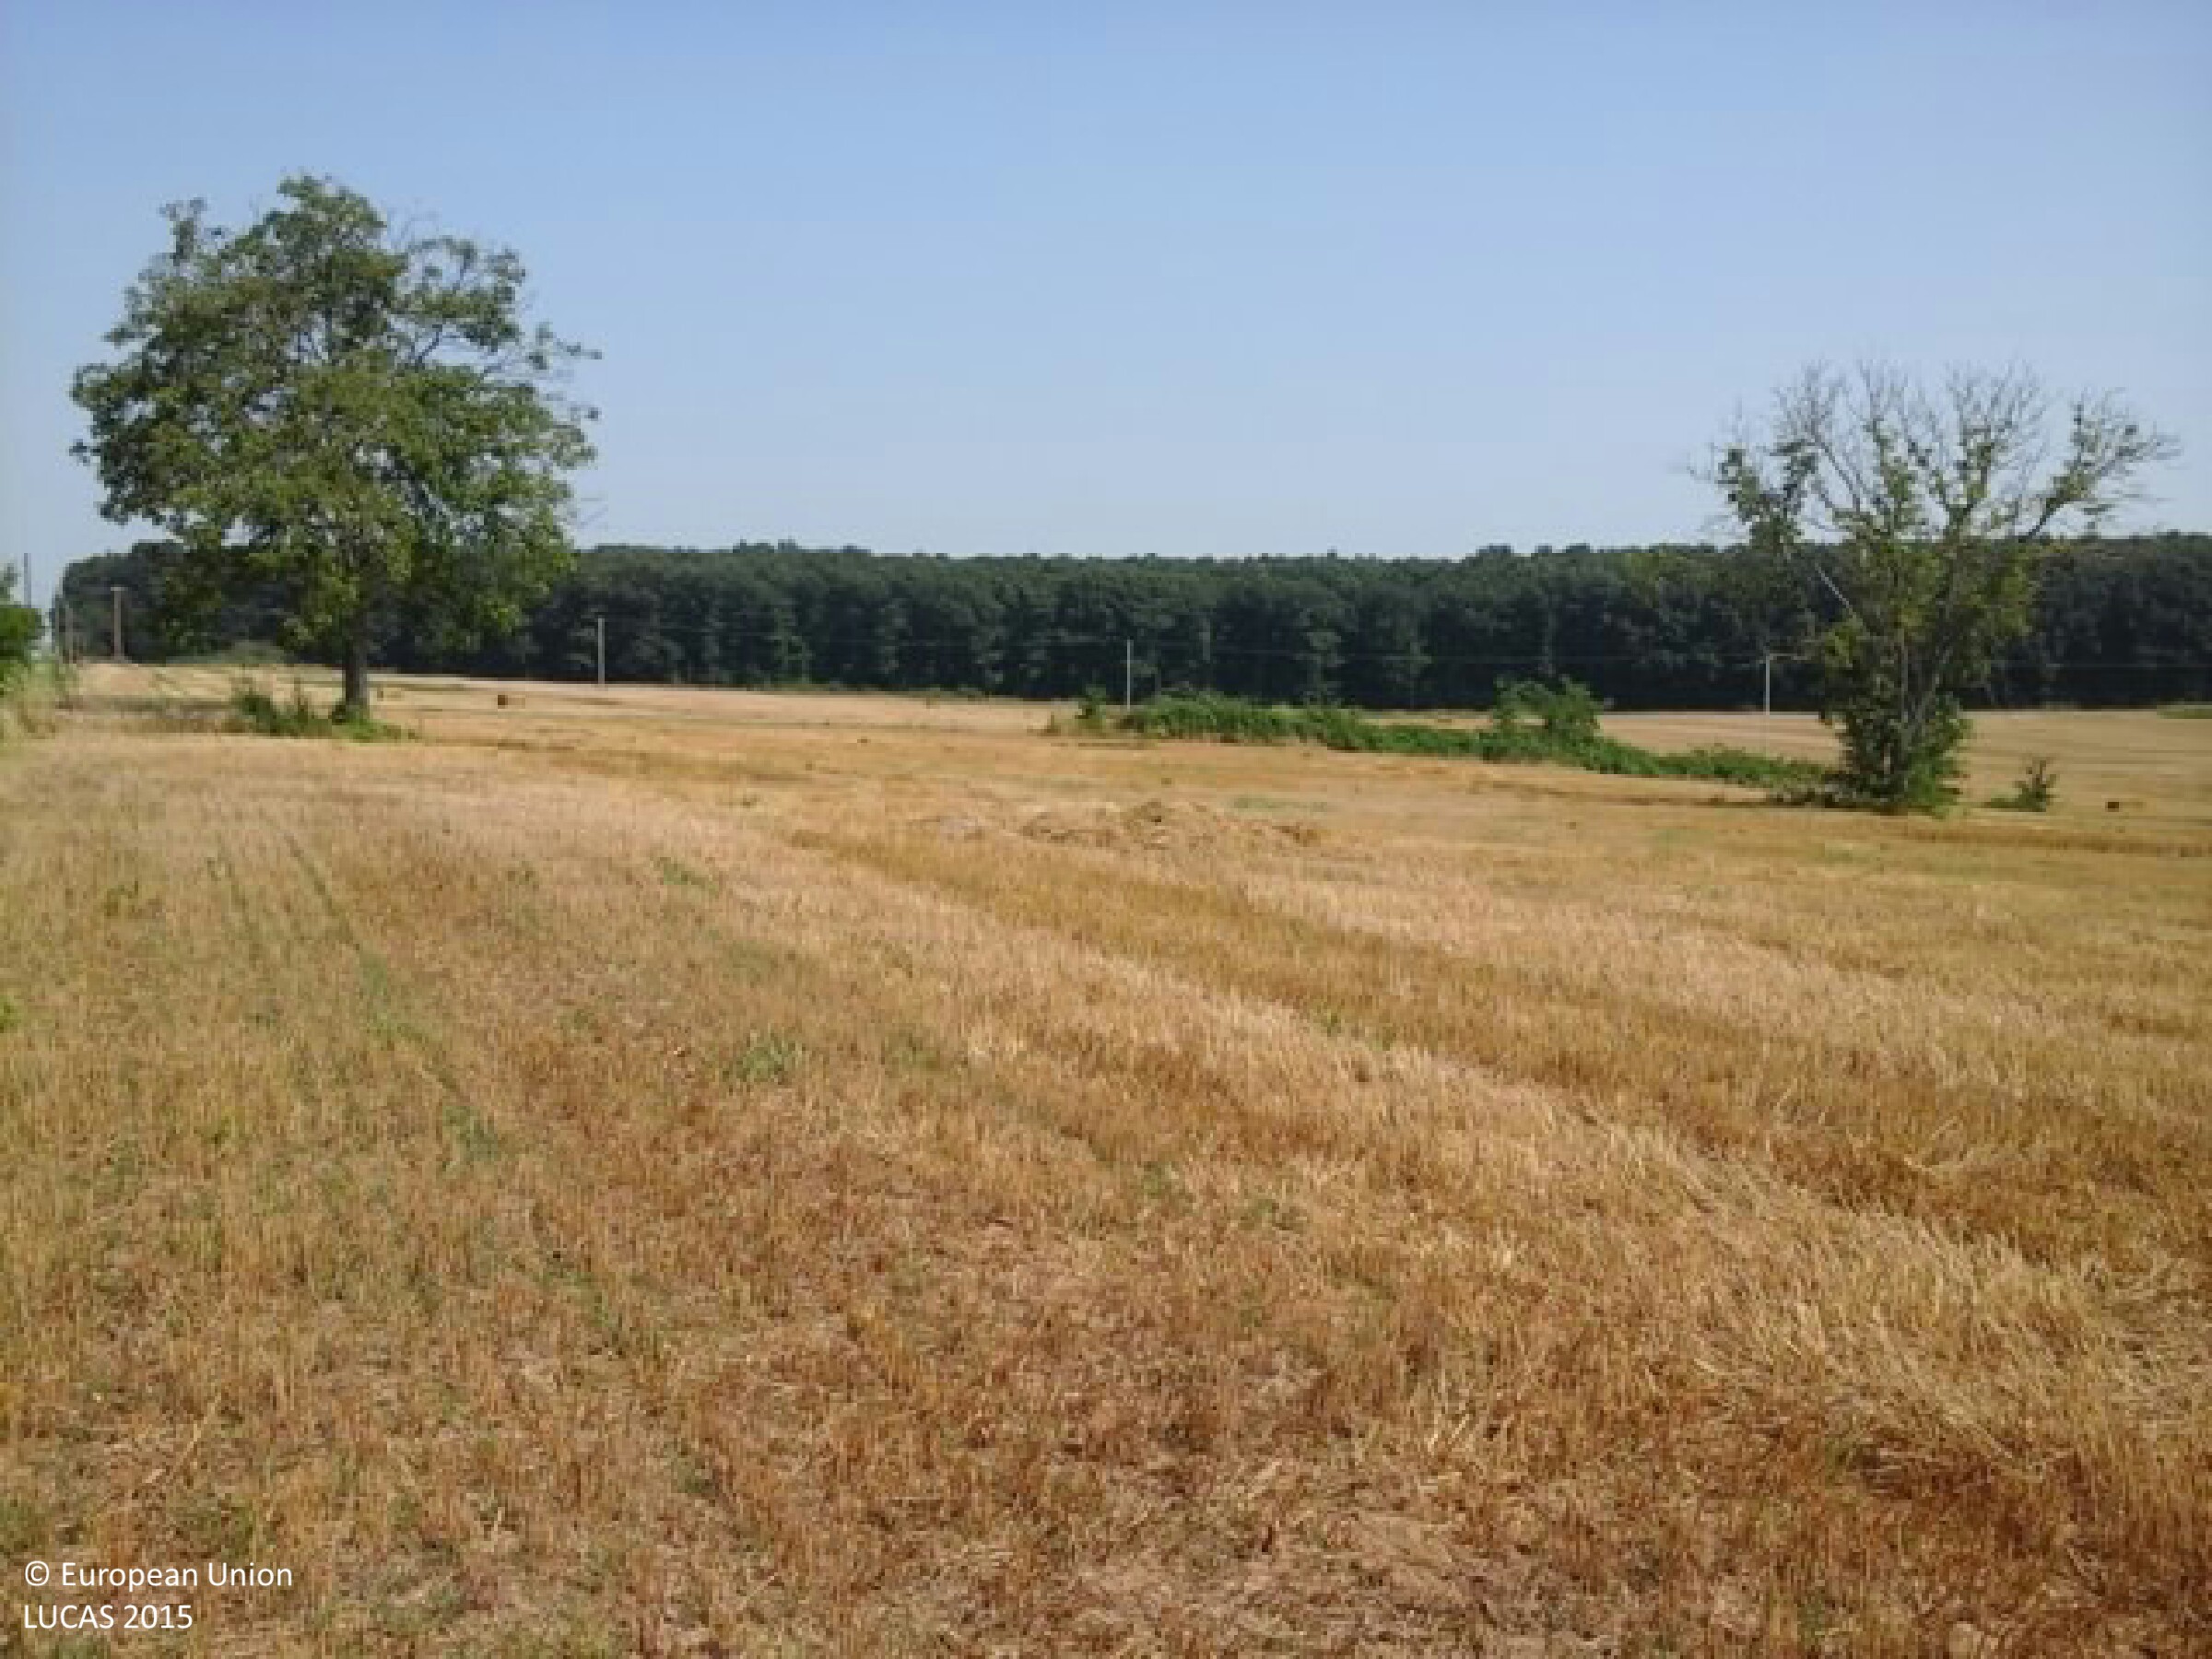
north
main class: Cropland
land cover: Common wheat
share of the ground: 50 - 75 %
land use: Agriculture (excluding fallow land and kitchen gardens)
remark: Harvested field
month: August
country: HU
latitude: 46.3153
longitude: 18.3329
